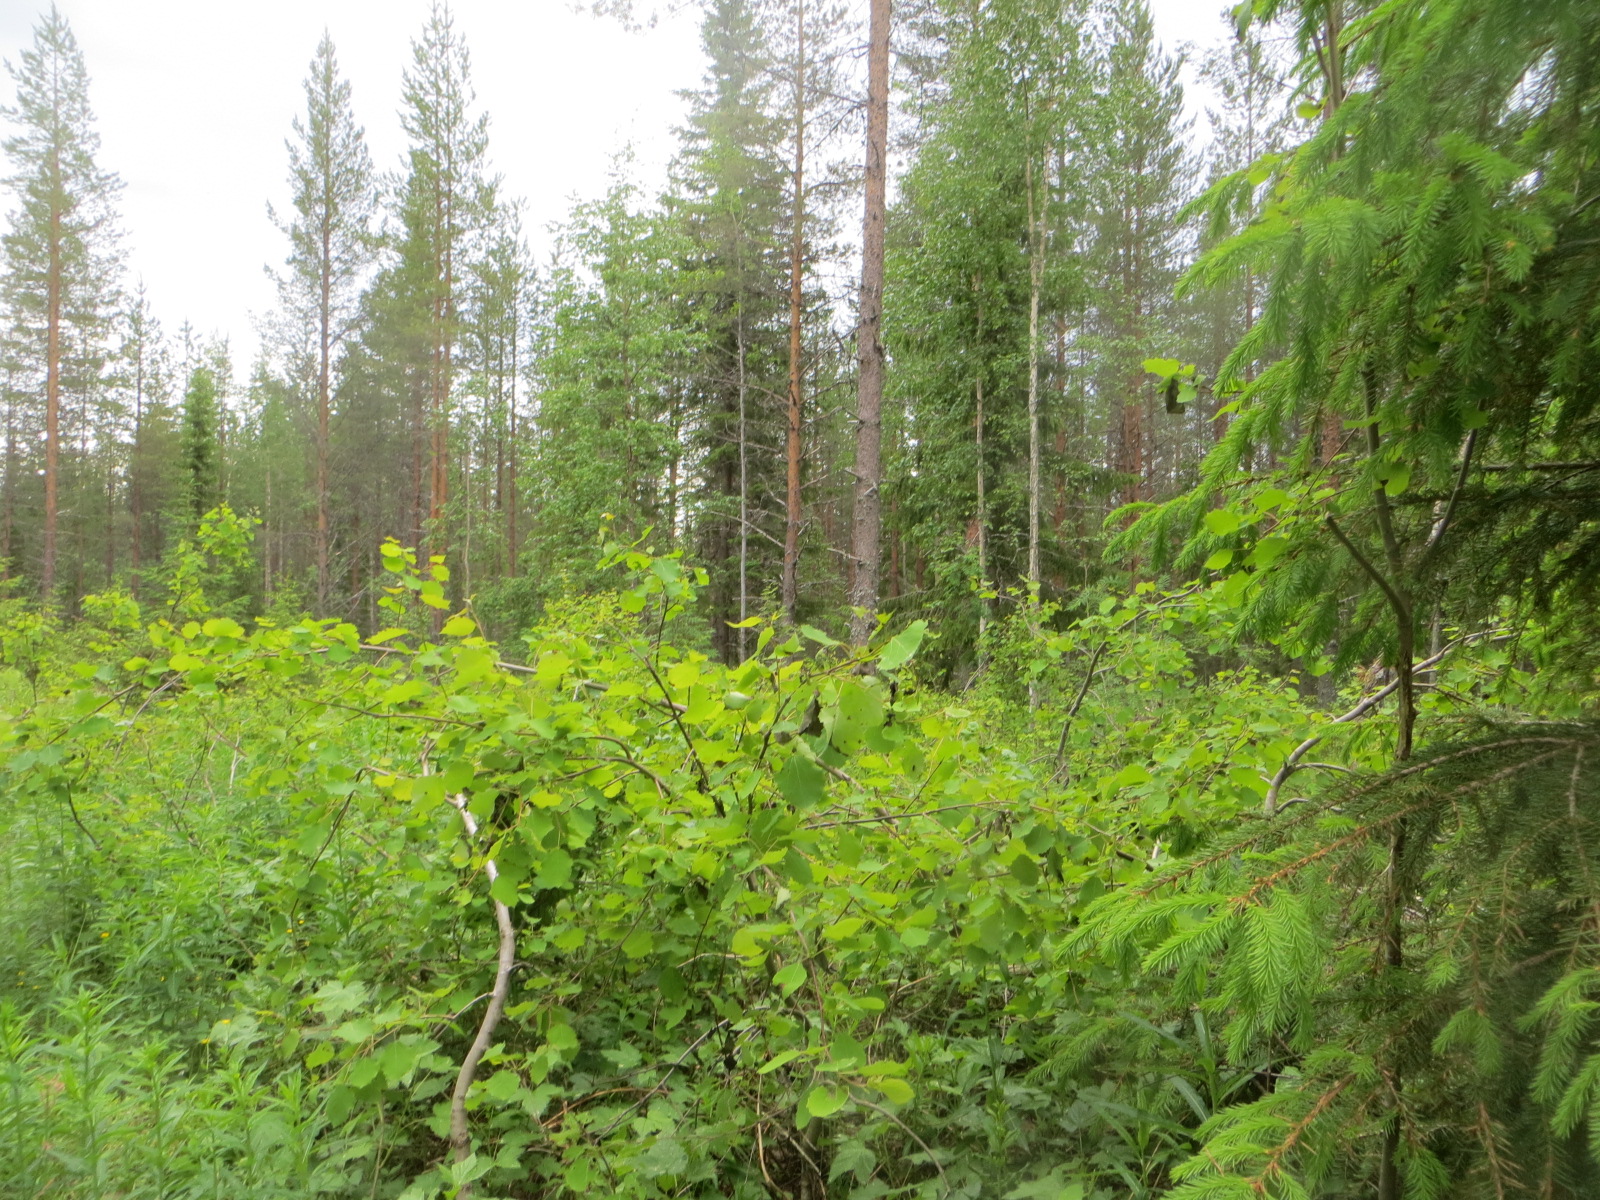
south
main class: Woodland
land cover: Spruce dominated mixed woodland
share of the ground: 25 - 50 %
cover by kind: herbaceous plants 40 %, coniferous forest trees 30 %, shrubs 20 %, broadleaved forest trees 10 %
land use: Forestry
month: June
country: FI
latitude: 65.6279
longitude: 26.6300
